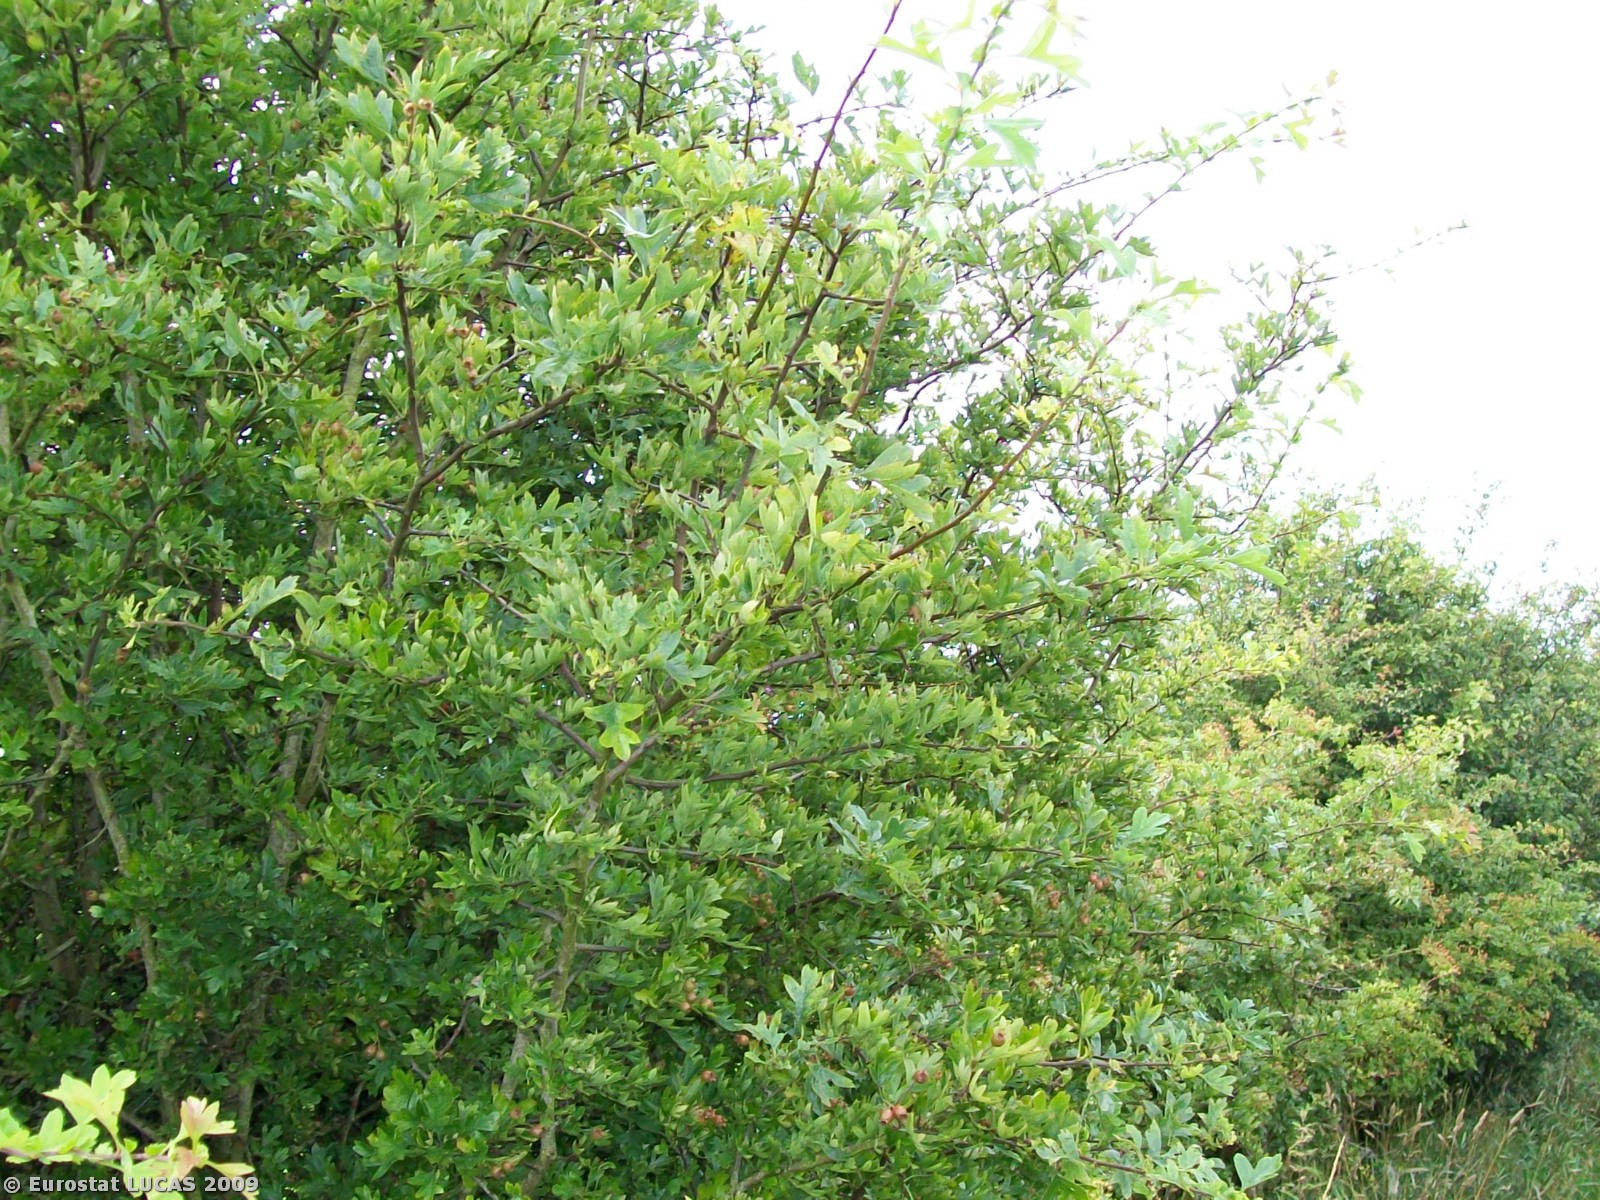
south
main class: Grassland
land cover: Grassland without tree/shrub cover
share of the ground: > 75 %
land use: Agriculture (excluding fallow land and kitchen gardens)
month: July
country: GB
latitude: 55.0705
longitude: -3.3099
